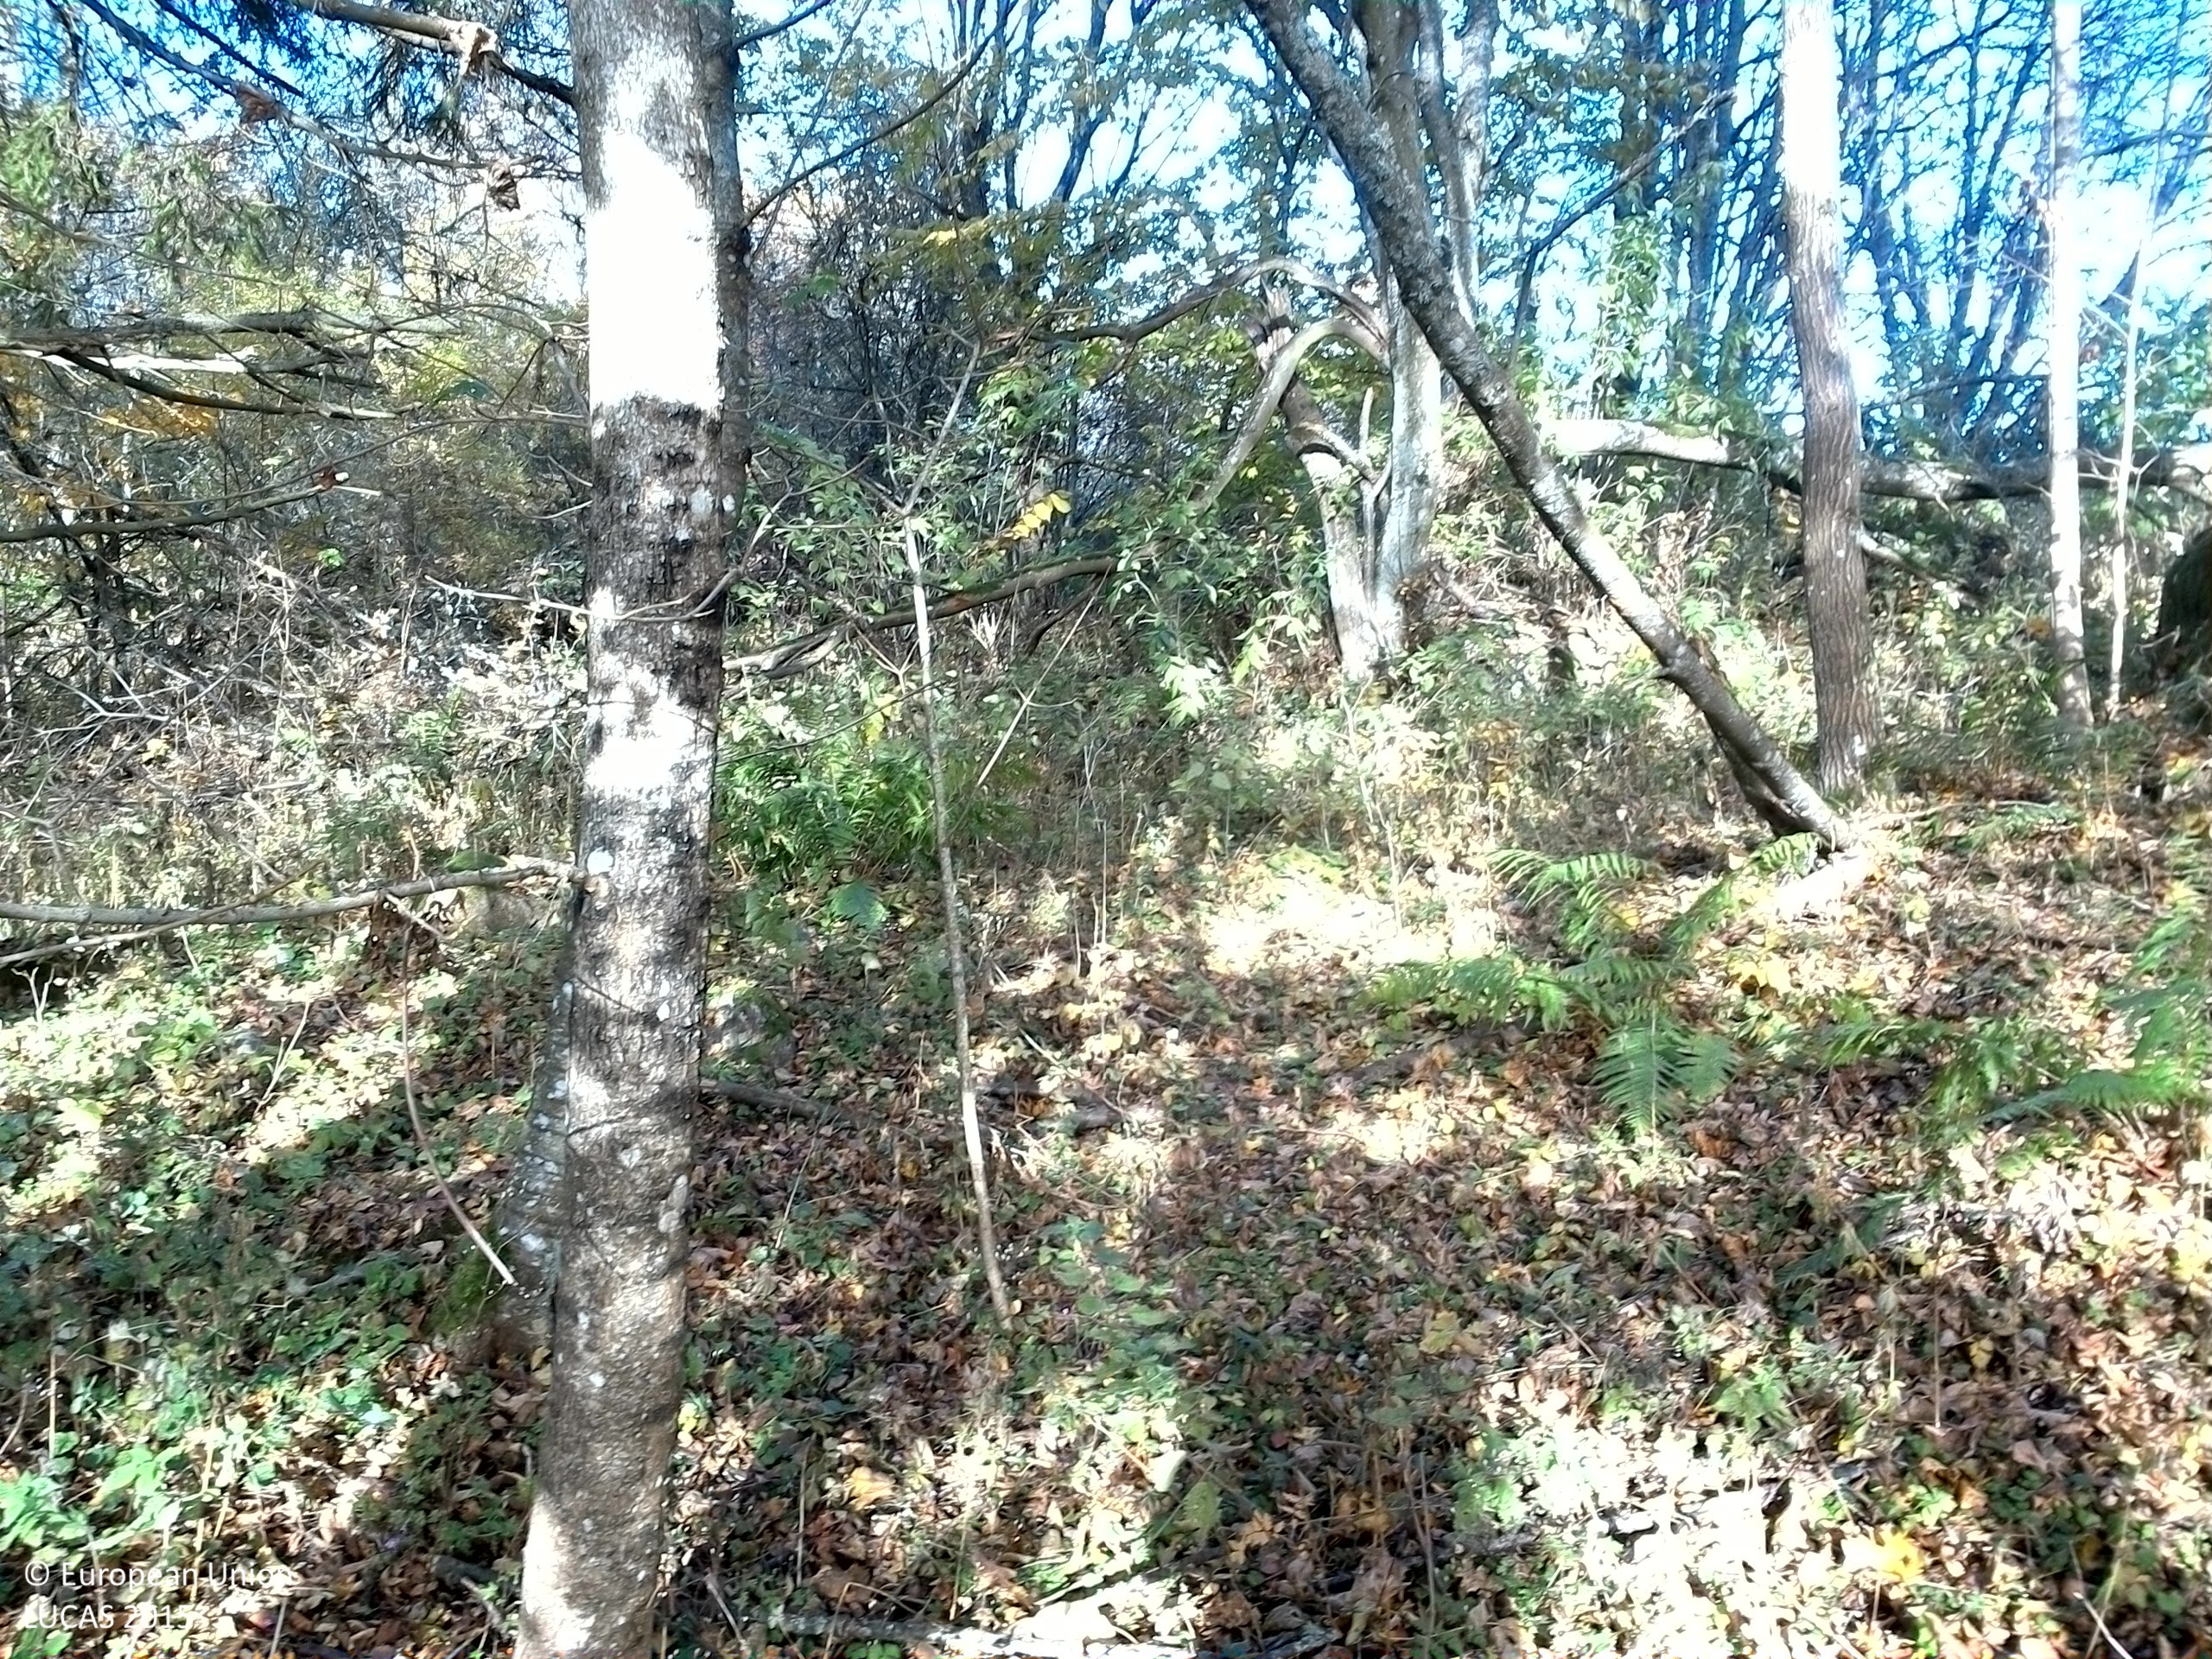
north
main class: Woodland
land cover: Broadleaved woodland
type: hemiboreal forest and nemoral coniferous forest and mixed broadleaved-coniferous forest
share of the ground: > 75 %
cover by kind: broadleaved forest trees 75 %, shrubs 10 %, herbaceous plants 10 %, consolidated bare surface 5 %
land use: Forestry
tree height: > 5 m
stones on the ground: < 10 %
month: October
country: SE
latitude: 59.4428
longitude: 16.3231
